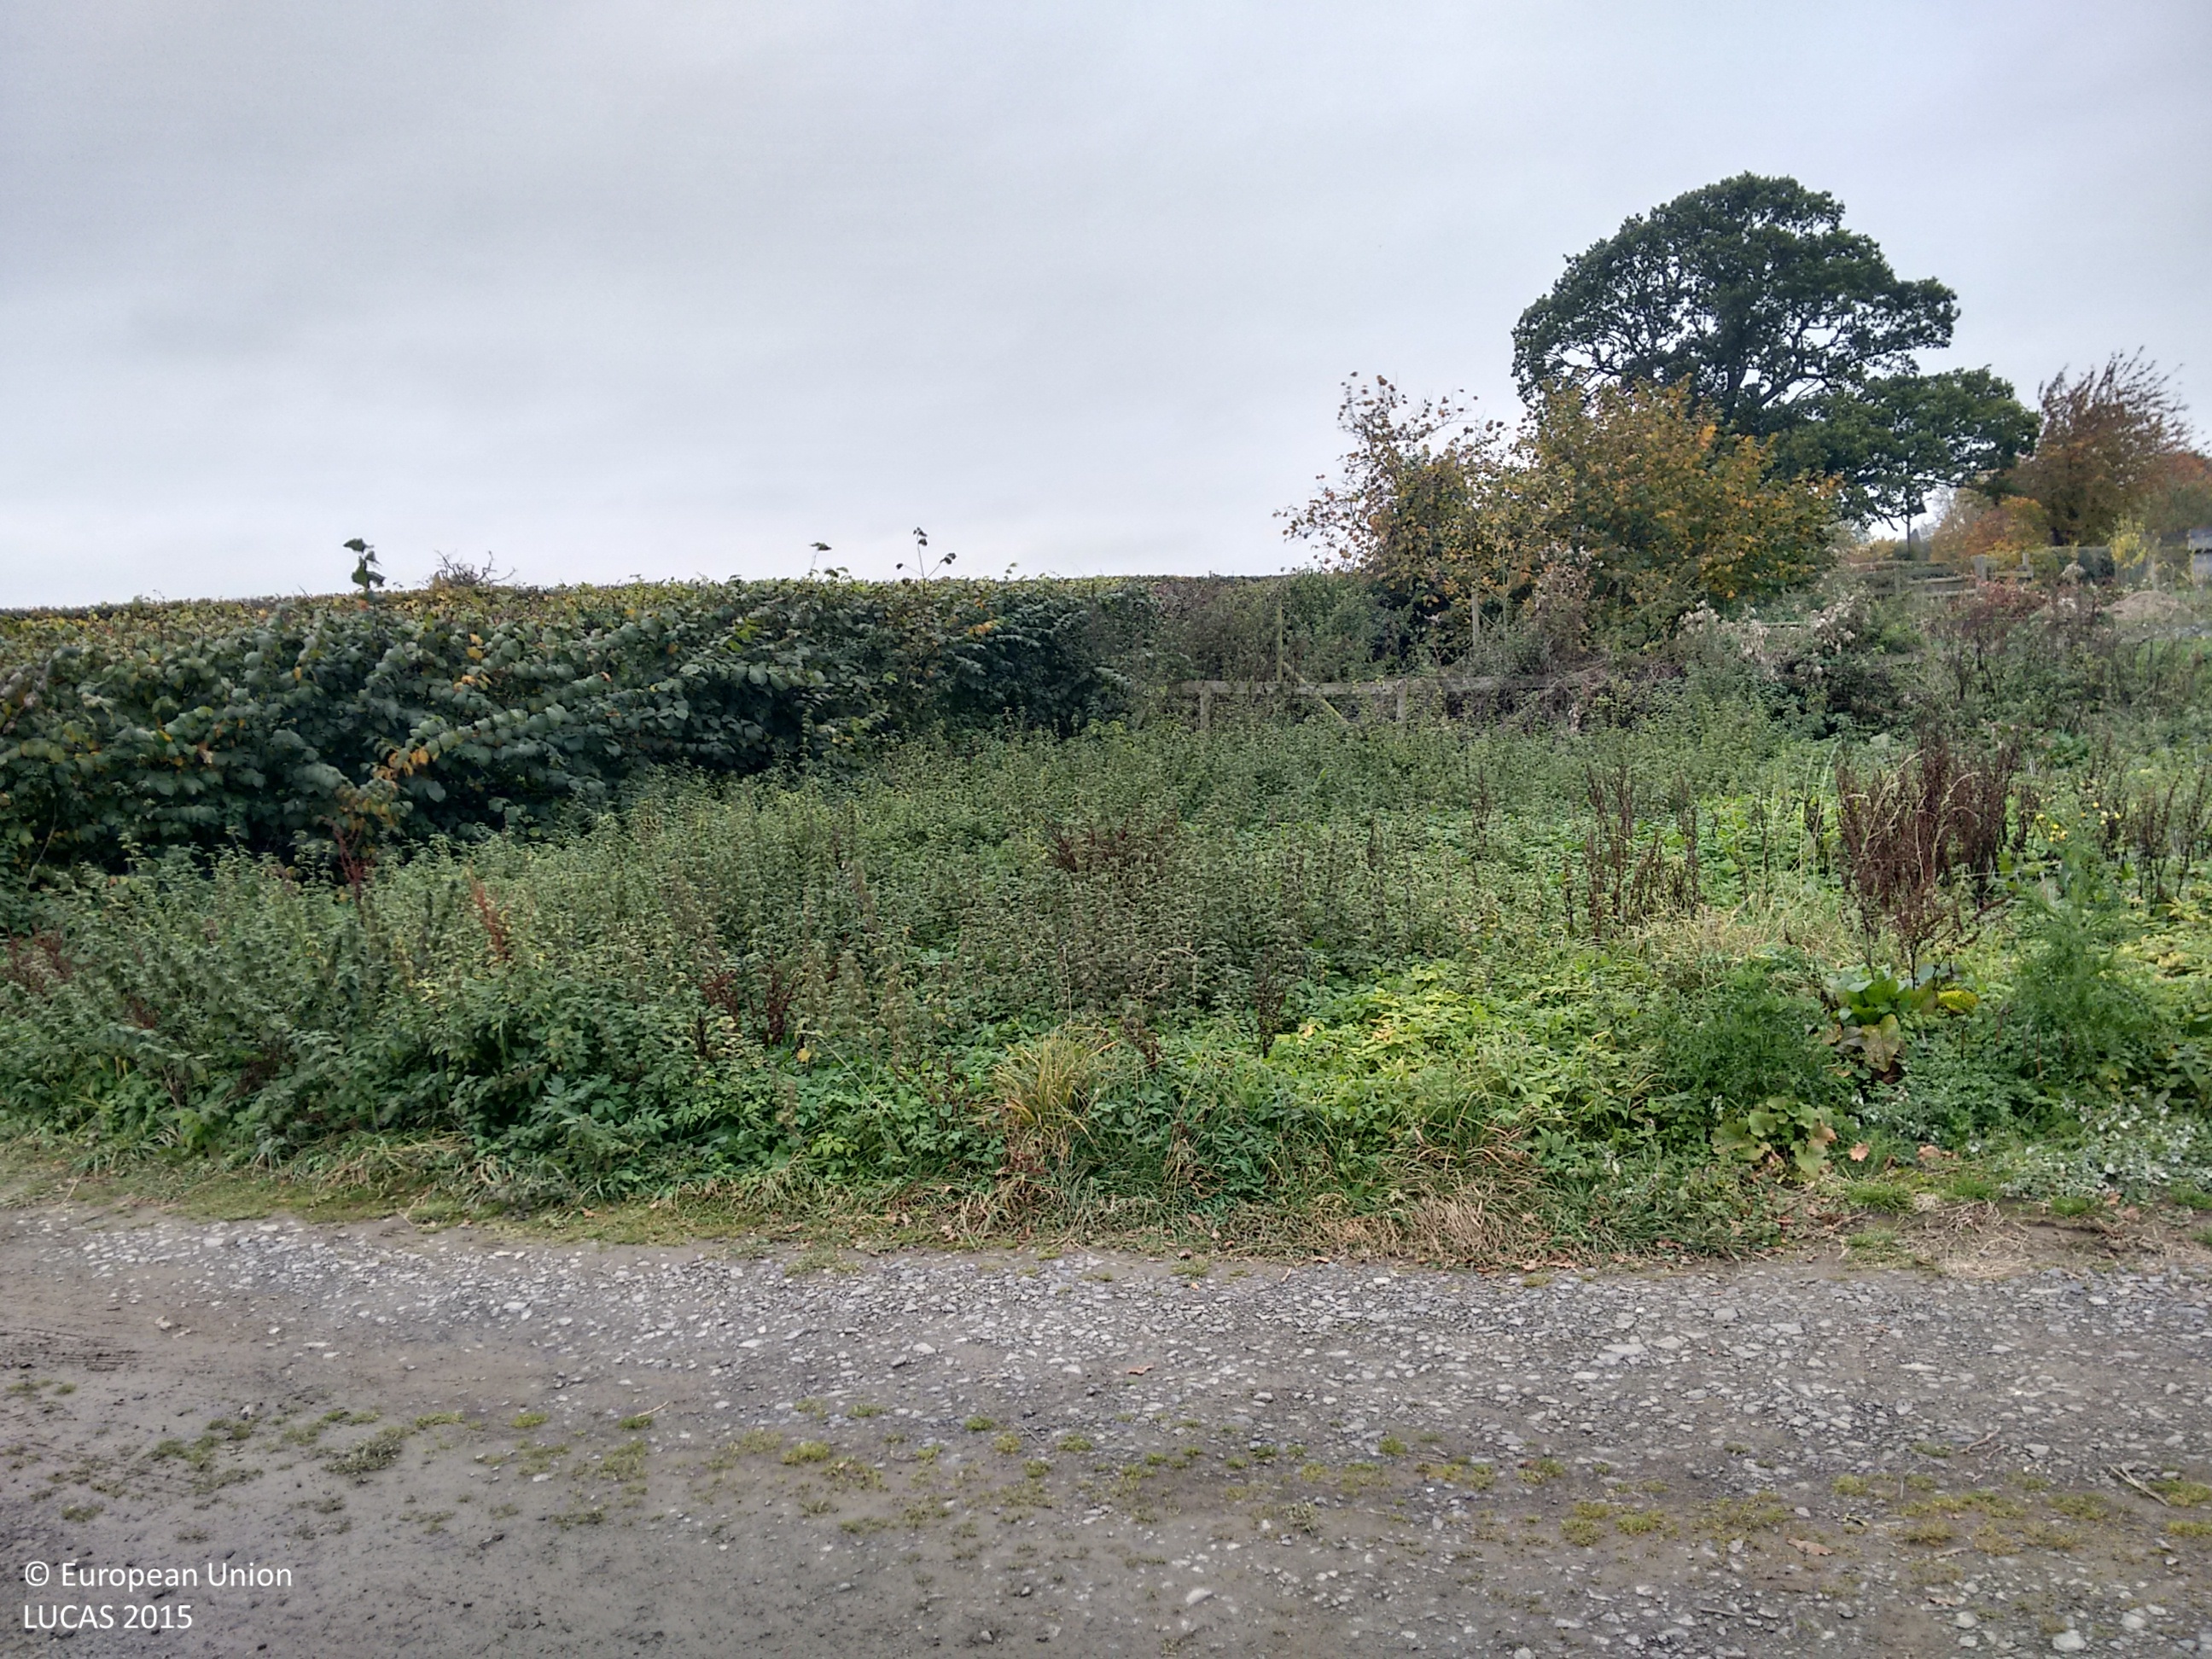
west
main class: Grassland
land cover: Grassland without tree/shrub cover
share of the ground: > 75 %
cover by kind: herbaceous plants 100 %
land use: Agriculture (excluding fallow land and kitchen gardens)
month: October
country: GB
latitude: 52.4284
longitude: -2.7928
